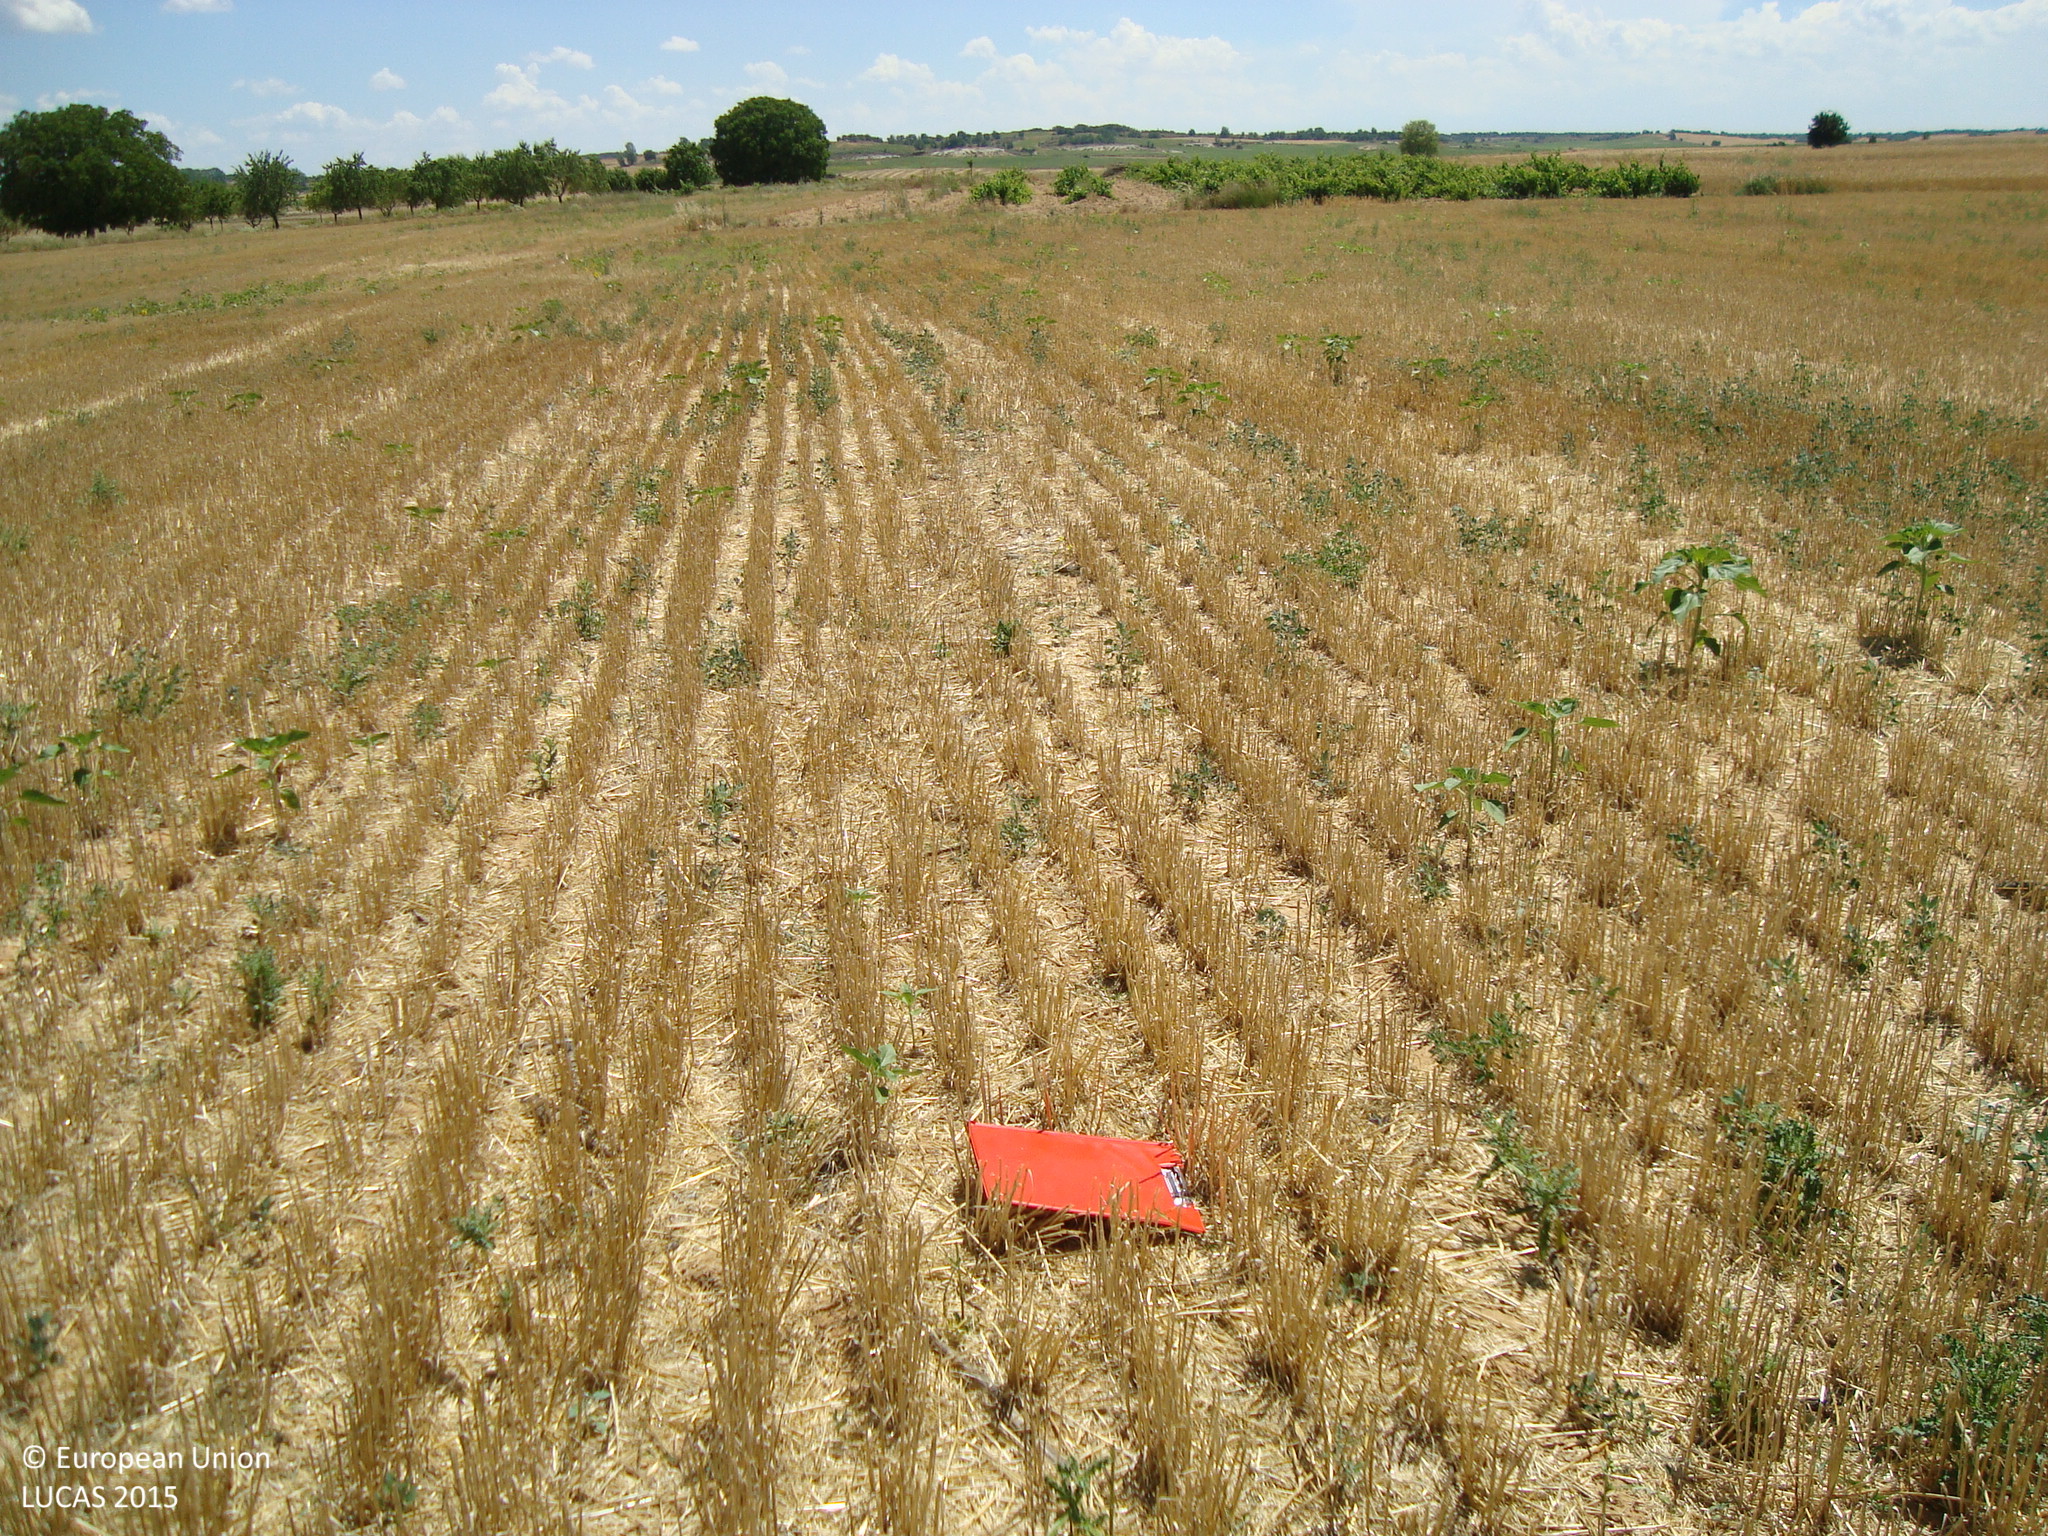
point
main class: Cropland
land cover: Barley
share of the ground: > 75 %
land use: Agriculture (excluding fallow land and kitchen gardens)
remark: Harvested field
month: July
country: ES
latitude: 41.8559
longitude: -3.6295
